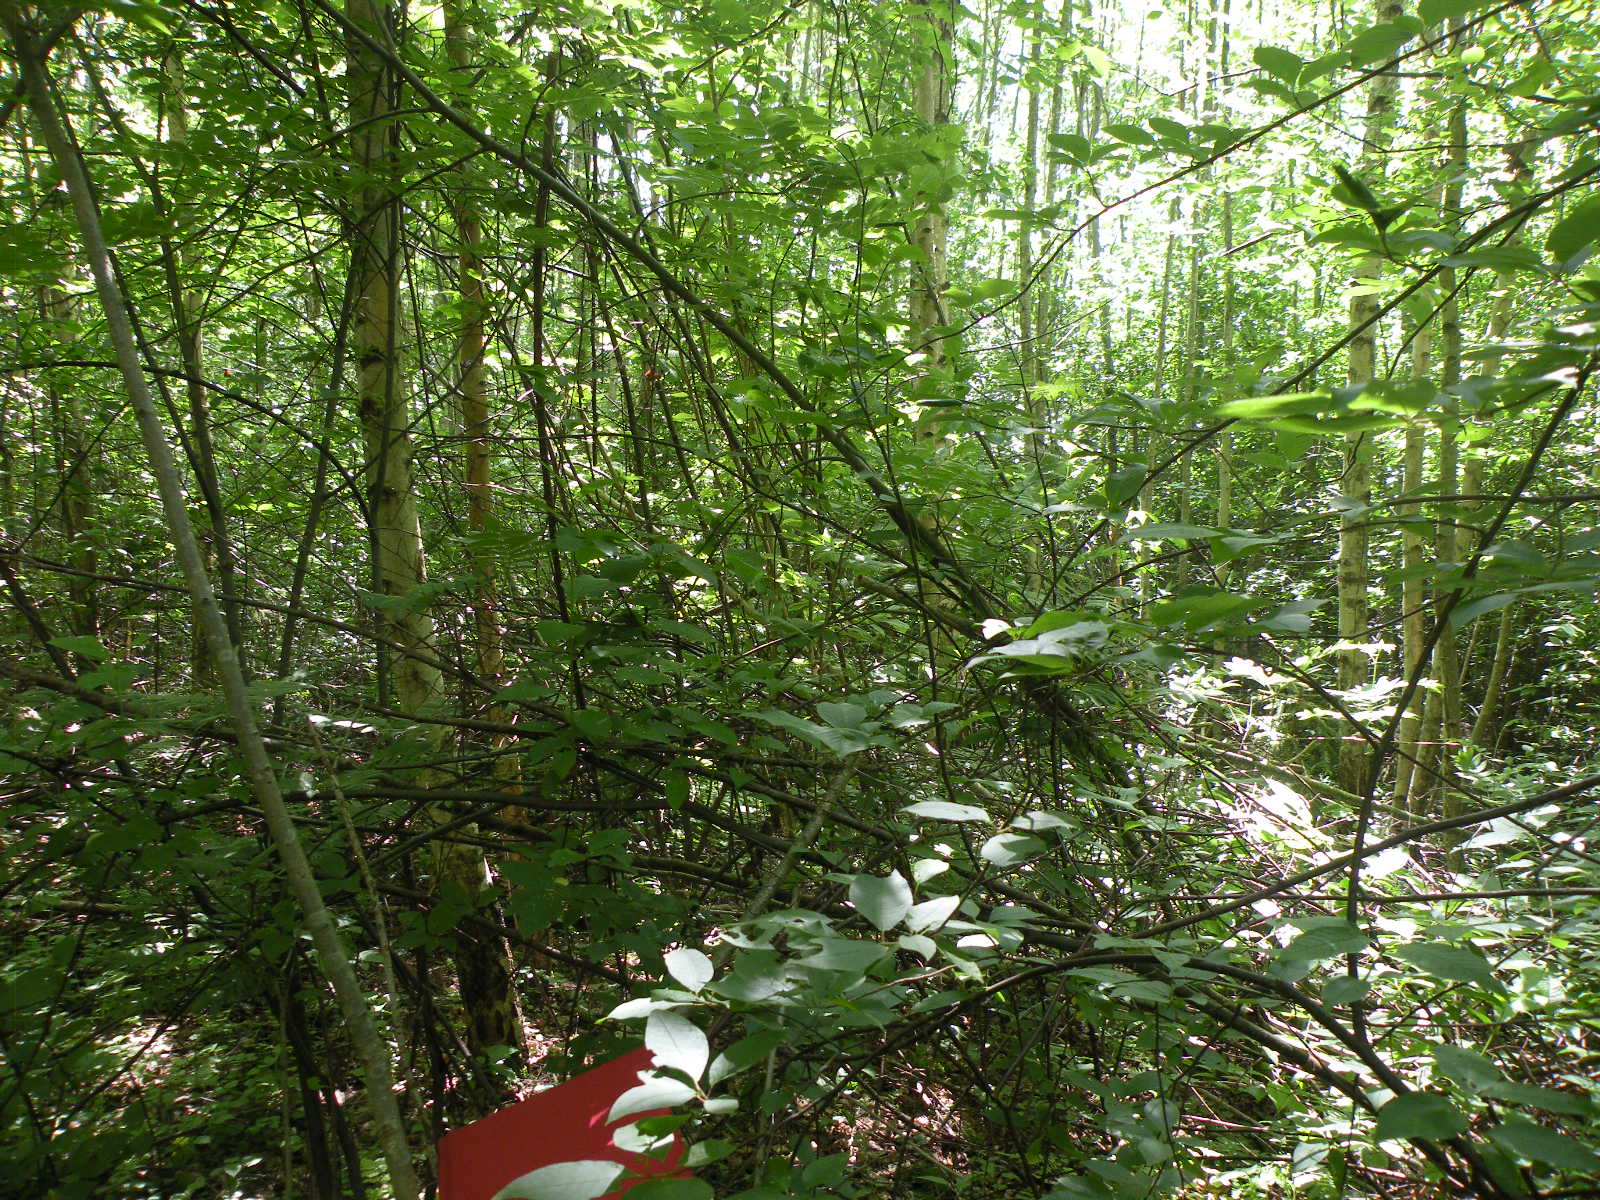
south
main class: Woodland
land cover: Broadleaved woodland
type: non-riverine alder, birch or aspen forest
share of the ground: > 75 %
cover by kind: broadleaved forest trees 80 %, shrubs 10 %, herbaceous plants 10 %
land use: Forestry
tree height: > 5 m
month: May
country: LV
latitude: 55.9736
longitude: 26.2138
